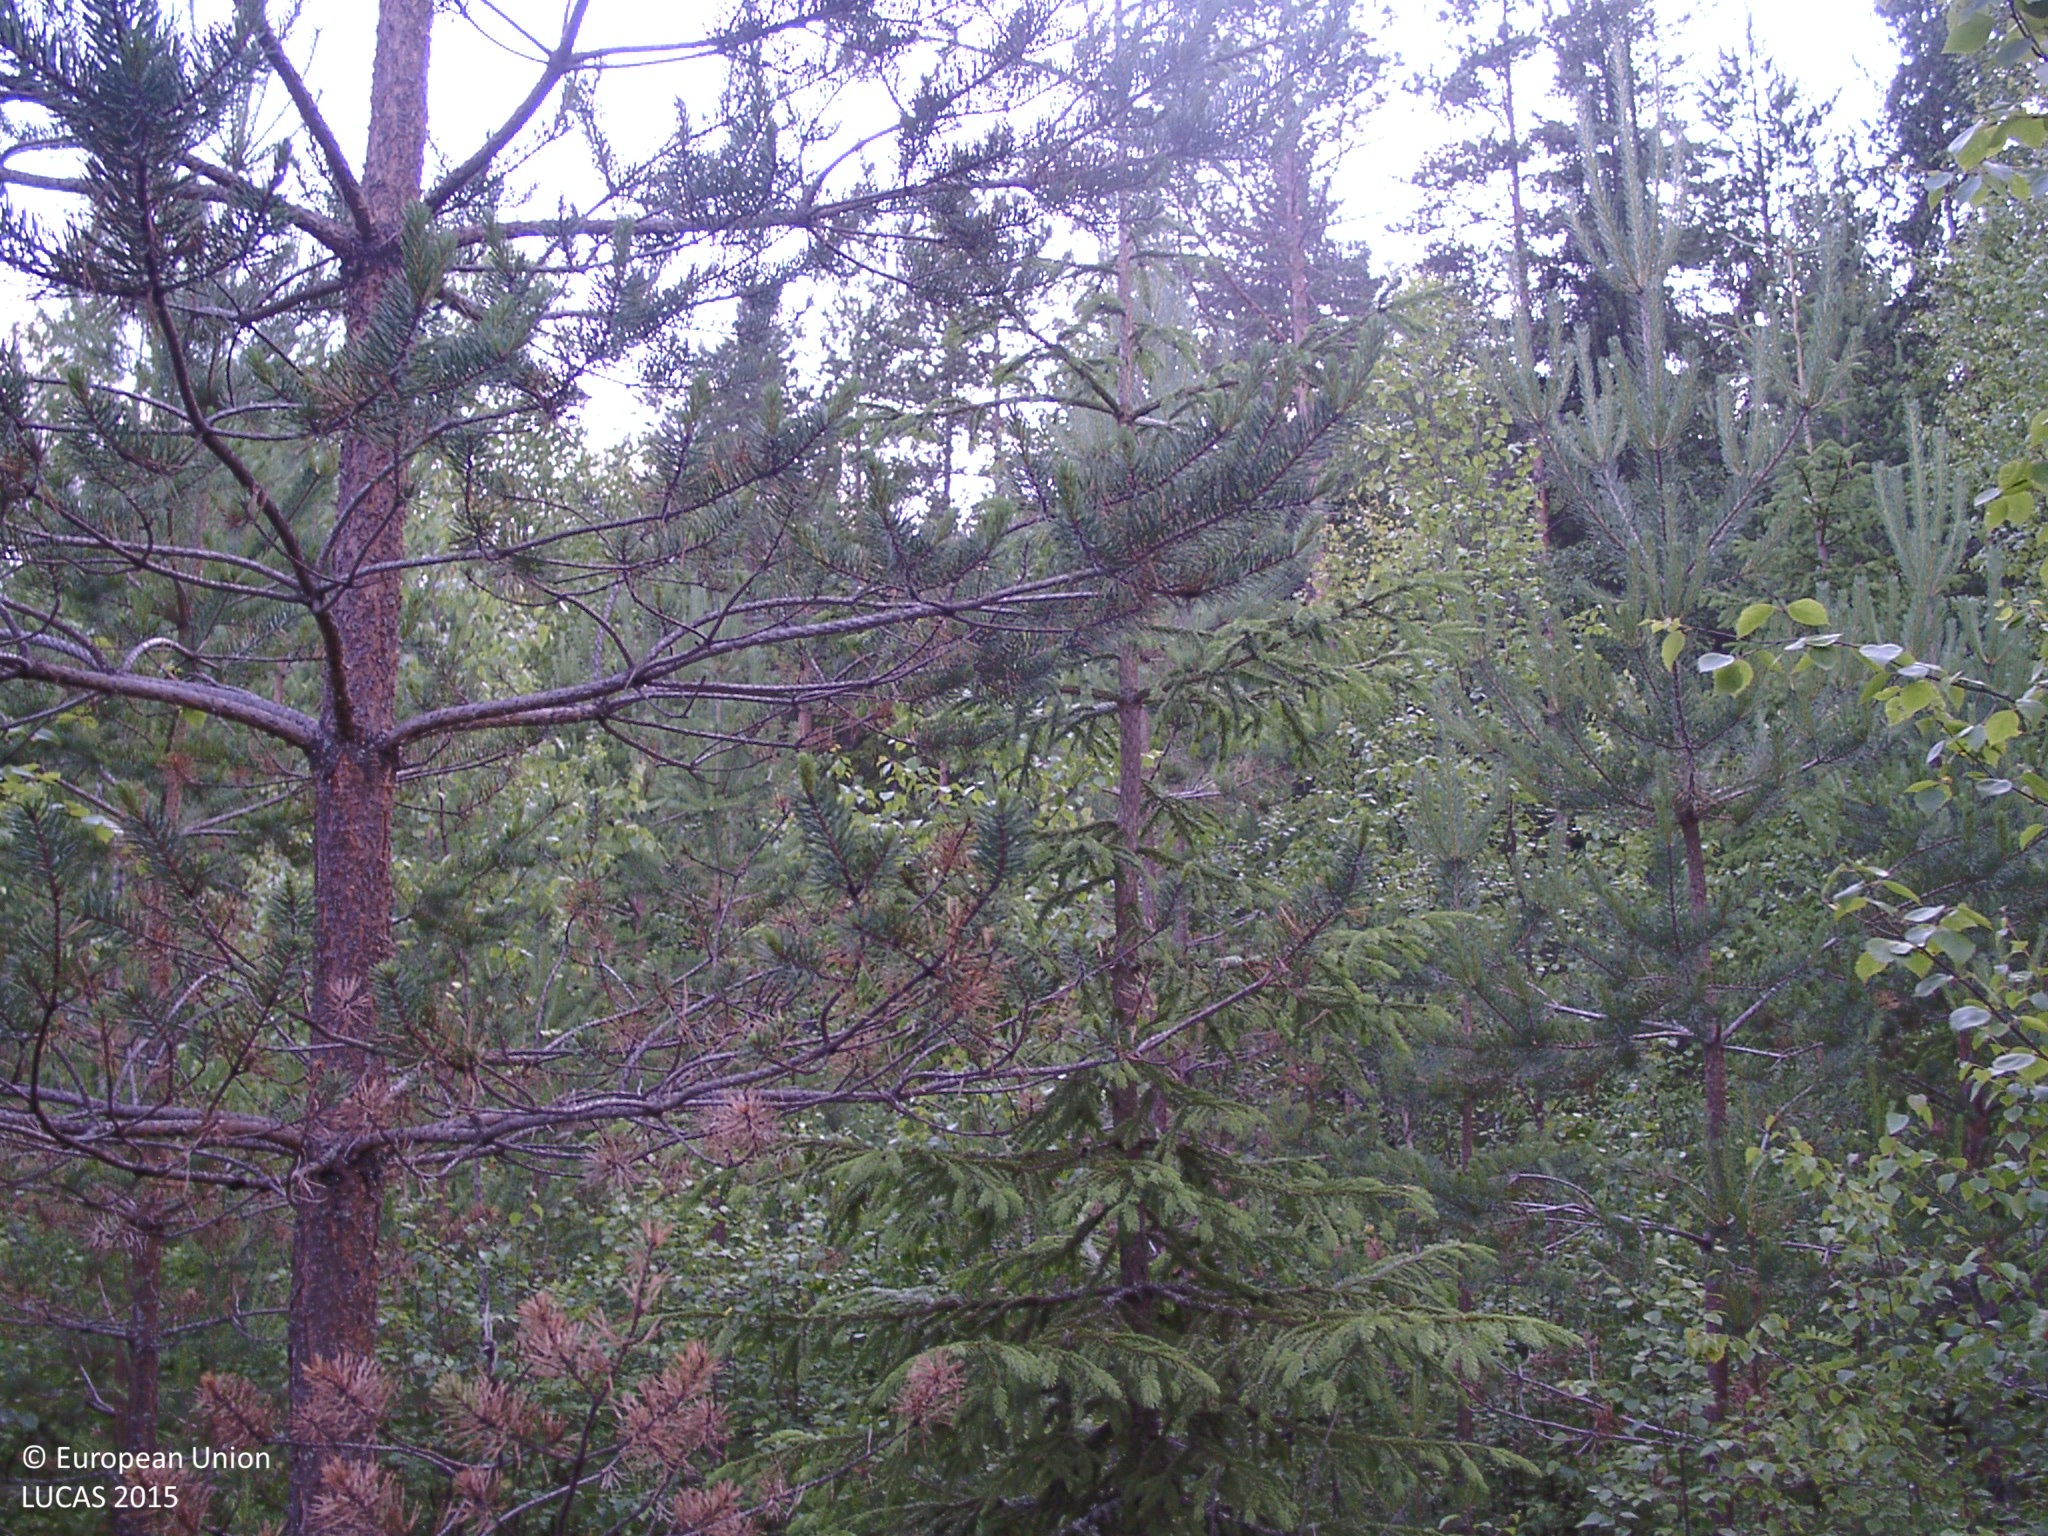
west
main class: Woodland
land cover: Other mixed woodland
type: boreal forest
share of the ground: 50 - 75 %
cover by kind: coniferous forest trees 50 %, broadleaved forest trees 20 %, shrubs 15 %, herbaceous plants 5 %, lichens and mosses 5 %
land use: Forestry
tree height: < 5 m
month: July
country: FI
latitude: 61.8399
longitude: 24.7842
